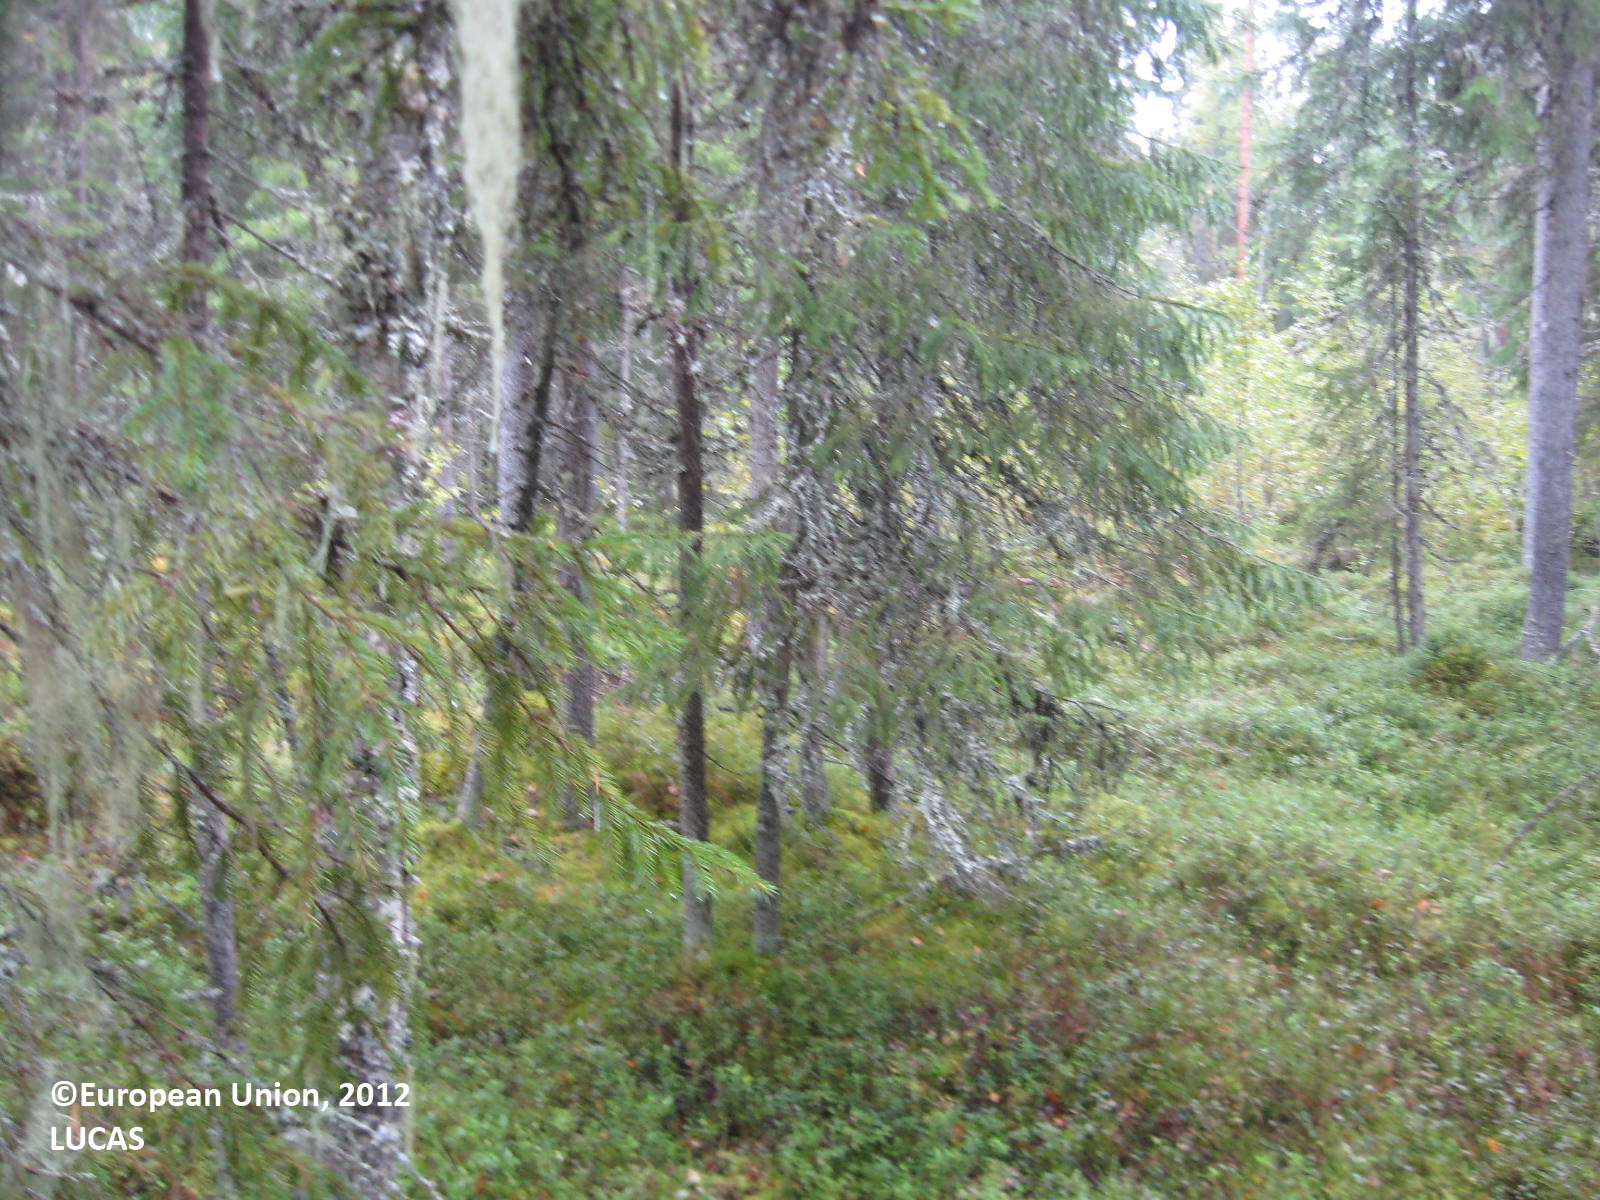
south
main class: Woodland
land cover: Other coniferous woodland
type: boreal forest
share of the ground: > 75 %
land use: Forestry
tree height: > 5 m
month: August
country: FI
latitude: 63.5250
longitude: 29.6340
